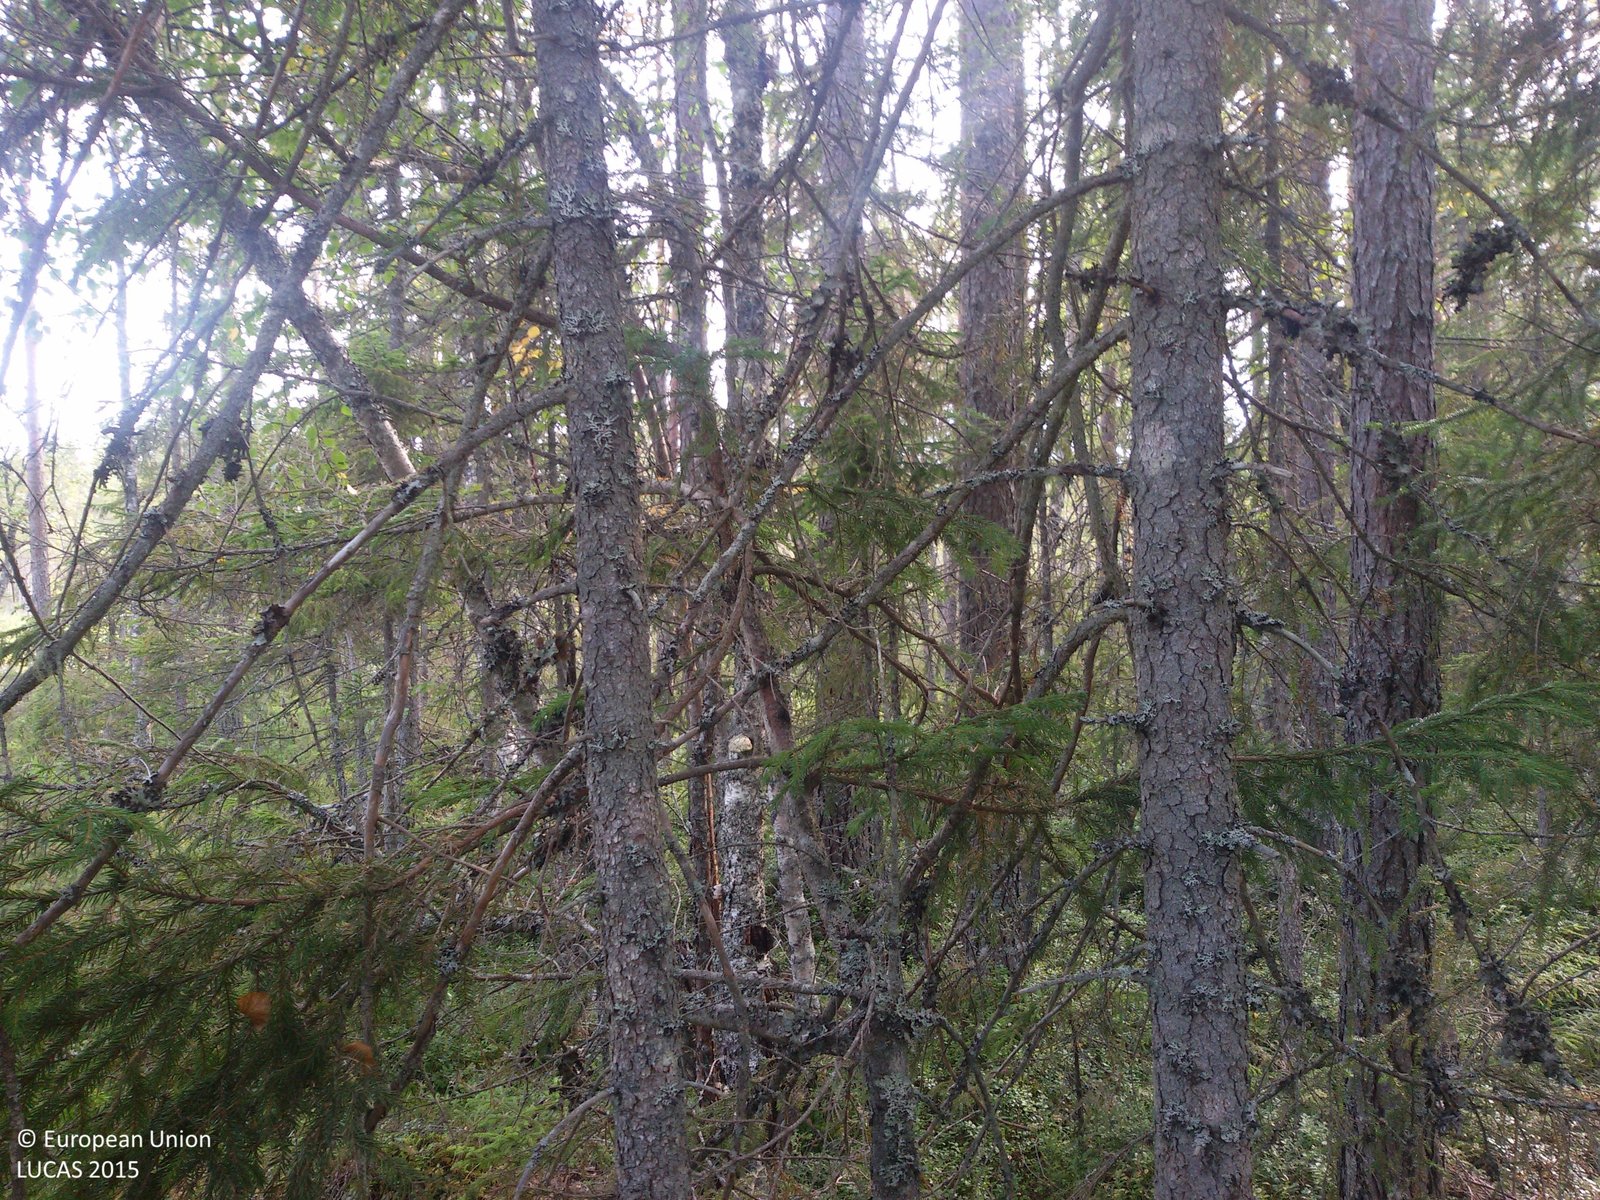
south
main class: Woodland
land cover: Pine dominated mixed woodland
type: boreal forest
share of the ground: 50 - 75 %
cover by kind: coniferous forest trees 45 %, broadleaved forest trees 25 %, herbaceous plants 15 %, lichens and mosses 15 %
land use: Forestry
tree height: > 5 m
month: September
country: SE
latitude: 60.8695
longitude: 15.4557
